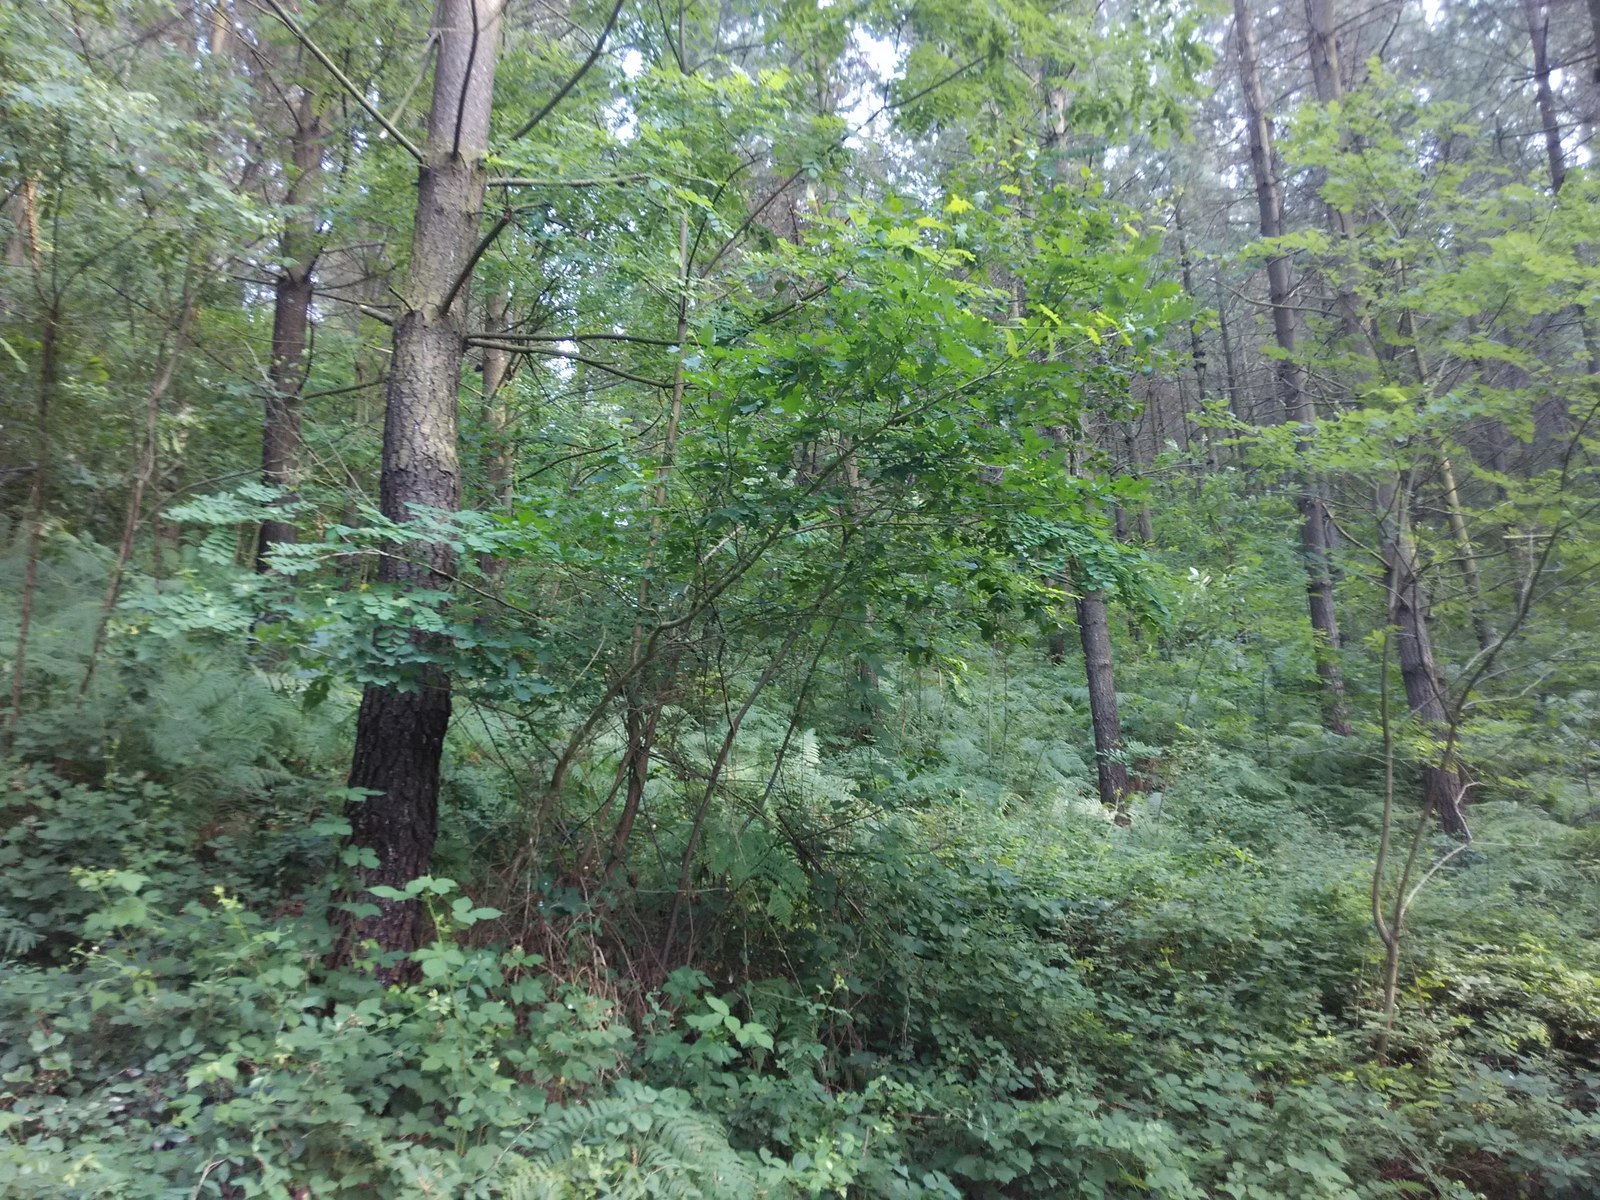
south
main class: Woodland
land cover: Pine dominated coniferous woodland
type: exotic forest
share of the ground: > 75 %
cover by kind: coniferous forest trees 100 %
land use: Forestry
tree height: > 5 m
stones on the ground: < 10 %
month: July
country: ES
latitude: 43.0371
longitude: -2.2607
